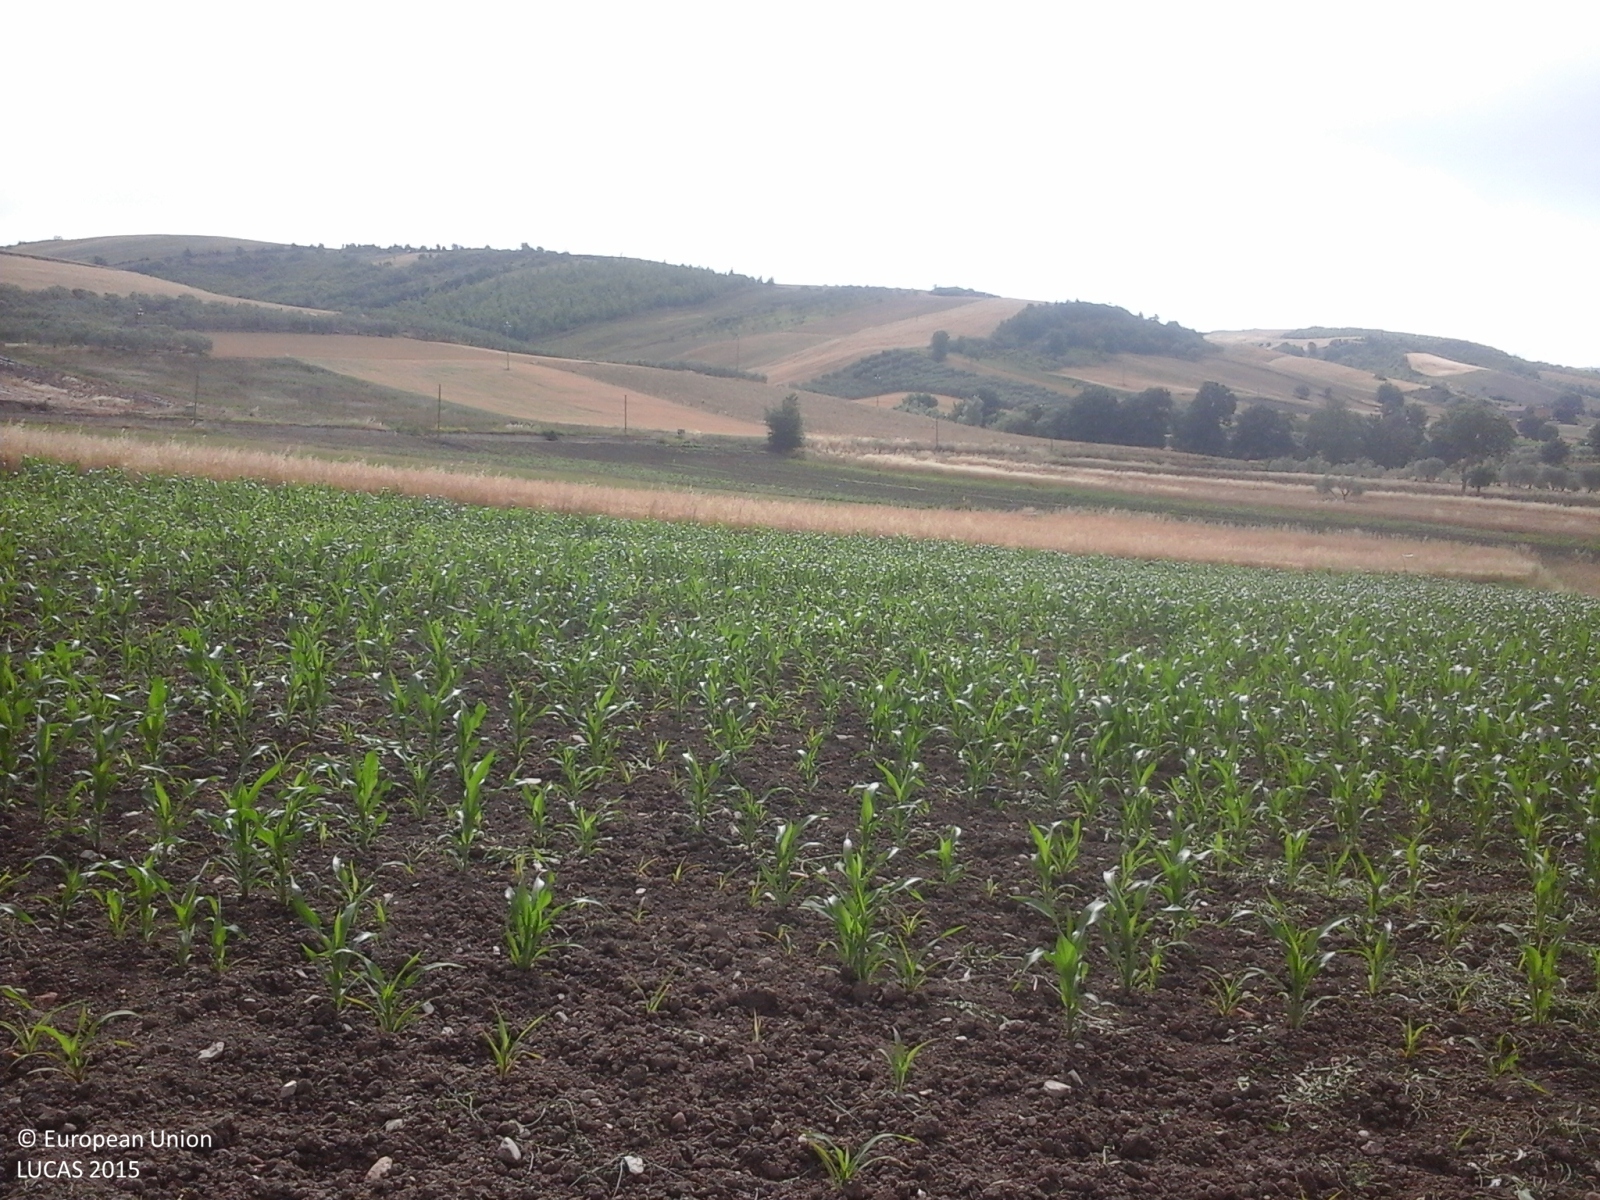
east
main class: Cropland
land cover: Maize
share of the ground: 25 - 50 %
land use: Agriculture (excluding fallow land and kitchen gardens)
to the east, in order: Maize; Barley; Spontaneously vegetated surfaces; Tracks; Maize; Tomatoes; Other fresh vegetables; Electric lines; Paved roads, cycling and walking lanes; Artificial constructions; Spontaneously vegetated surfaces; Common wheat
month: June
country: IT
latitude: 41.0381
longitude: 15.1552
